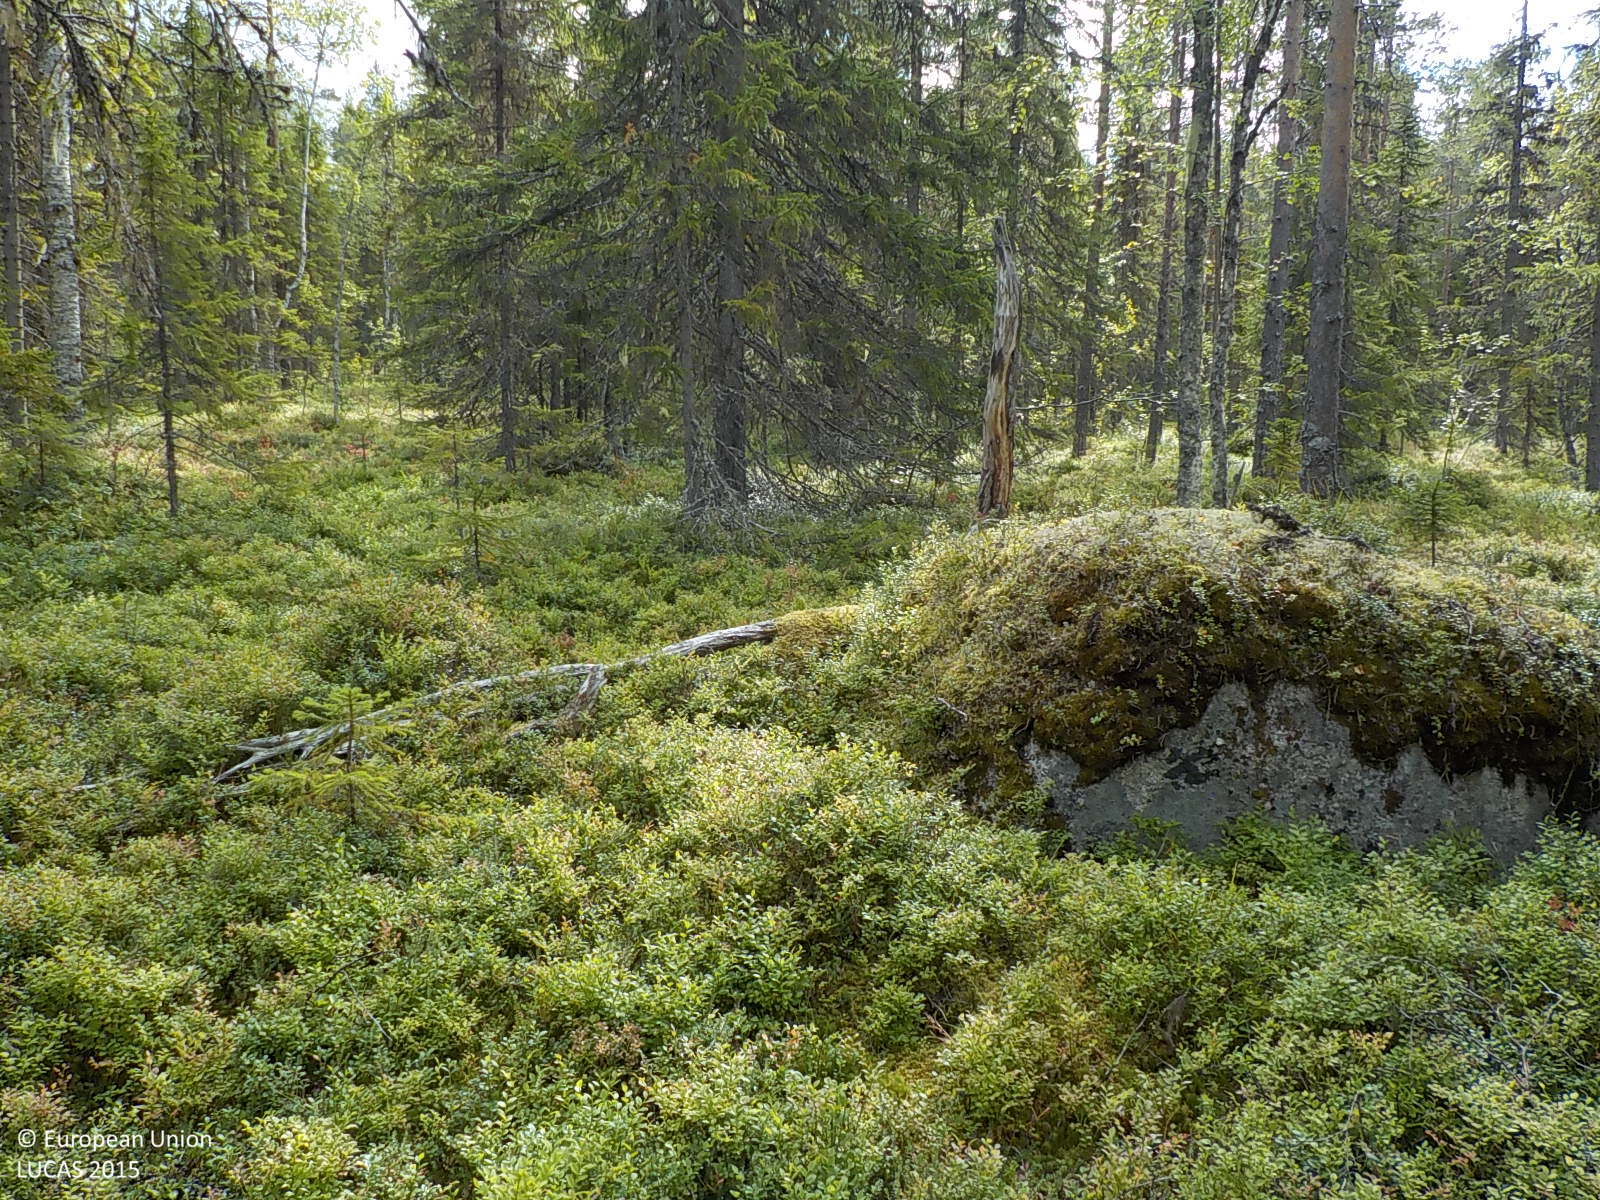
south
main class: Woodland
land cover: Pine dominated coniferous woodland
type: boreal forest
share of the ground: 50 - 75 %
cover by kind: coniferous forest trees 65 %, shrubs 35 %
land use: Forestry
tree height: > 5 m
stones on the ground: 25 - 50 %
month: September
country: SE
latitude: 63.3788
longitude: 17.2757
